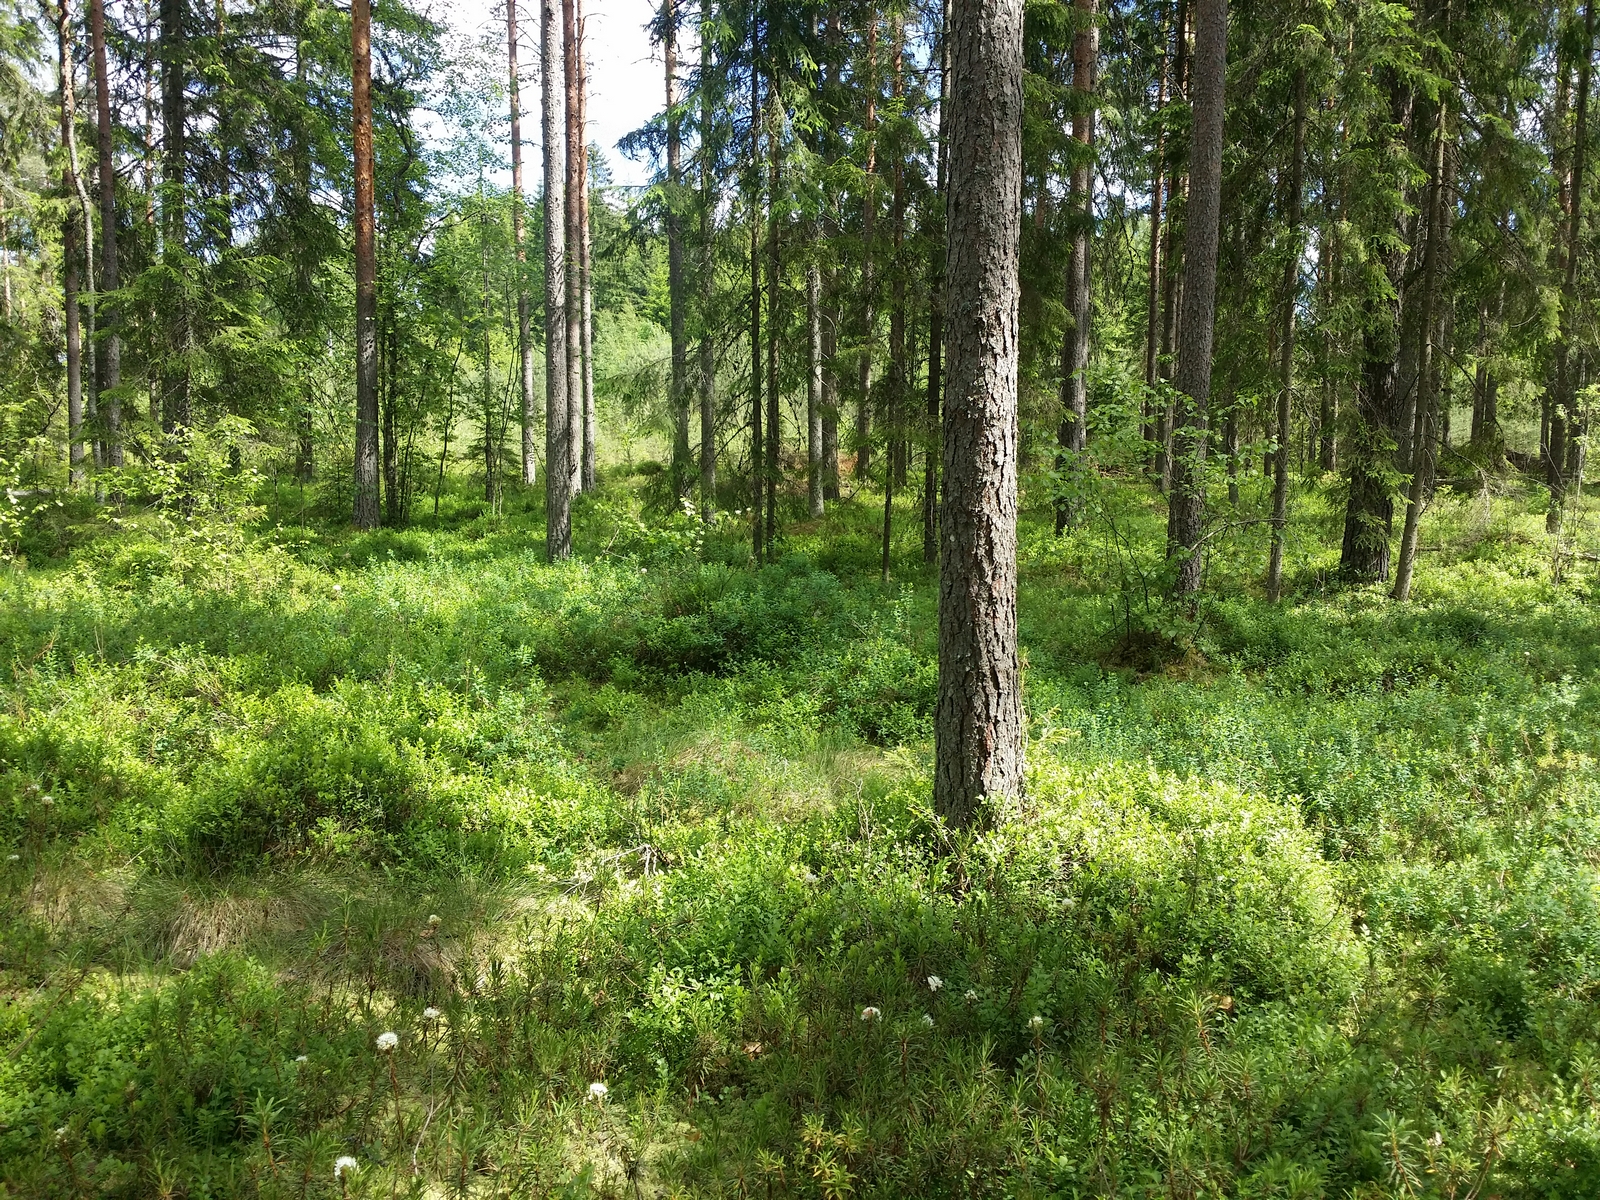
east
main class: Woodland
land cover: Other coniferous woodland
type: hemiboreal forest and nemoral coniferous forest and mixed broadleaved-coniferous forest
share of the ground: 50 - 75 %
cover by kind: coniferous forest trees 65 %, lichens and mosses 25 %, herbaceous plants 10 %
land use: Forestry
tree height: > 5 m
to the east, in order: Other coniferous woodland; Spruce dominated mixed woodland; Pine dominated coniferous woodland; Other mixed woodland; Spruce dominated mixed woodland; Broadleaved woodland; Spruce dominated mixed woodland; Broadleaved woodland
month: June
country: LV
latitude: 57.2869
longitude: 26.4509
